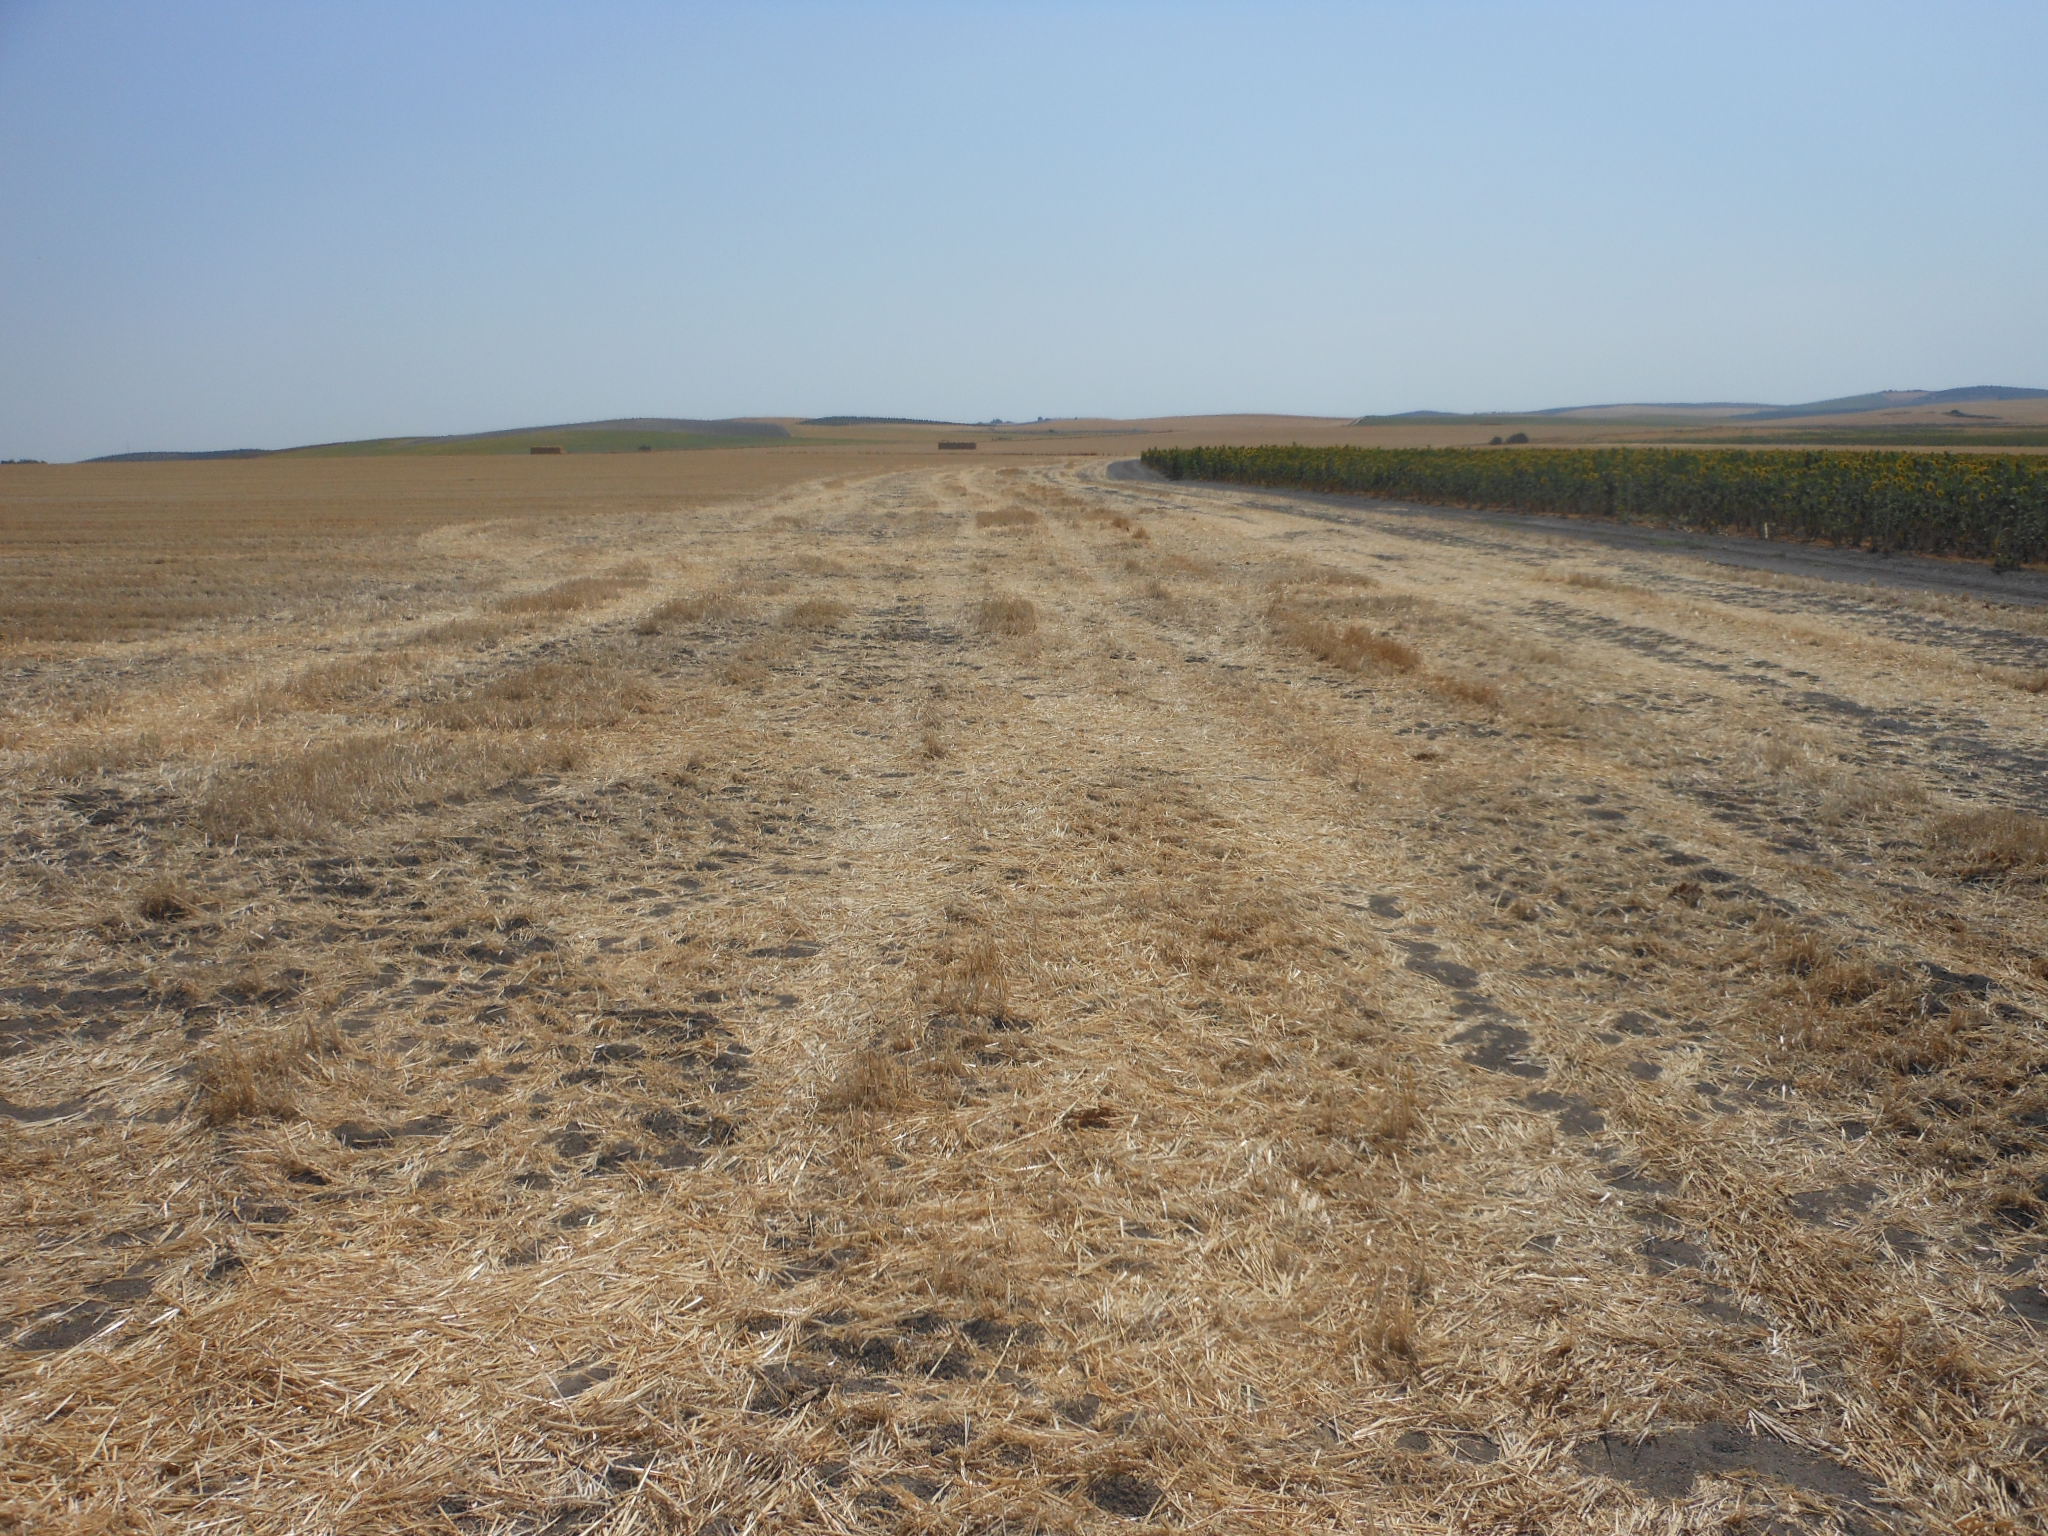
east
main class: Cropland
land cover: Durum wheat
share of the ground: < 10 %
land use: Agriculture (excluding fallow land and kitchen gardens)
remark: Harvested field
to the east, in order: Durum wheat; Tracks; Sunflower
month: June
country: ES
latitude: 37.3937
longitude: -5.1355
